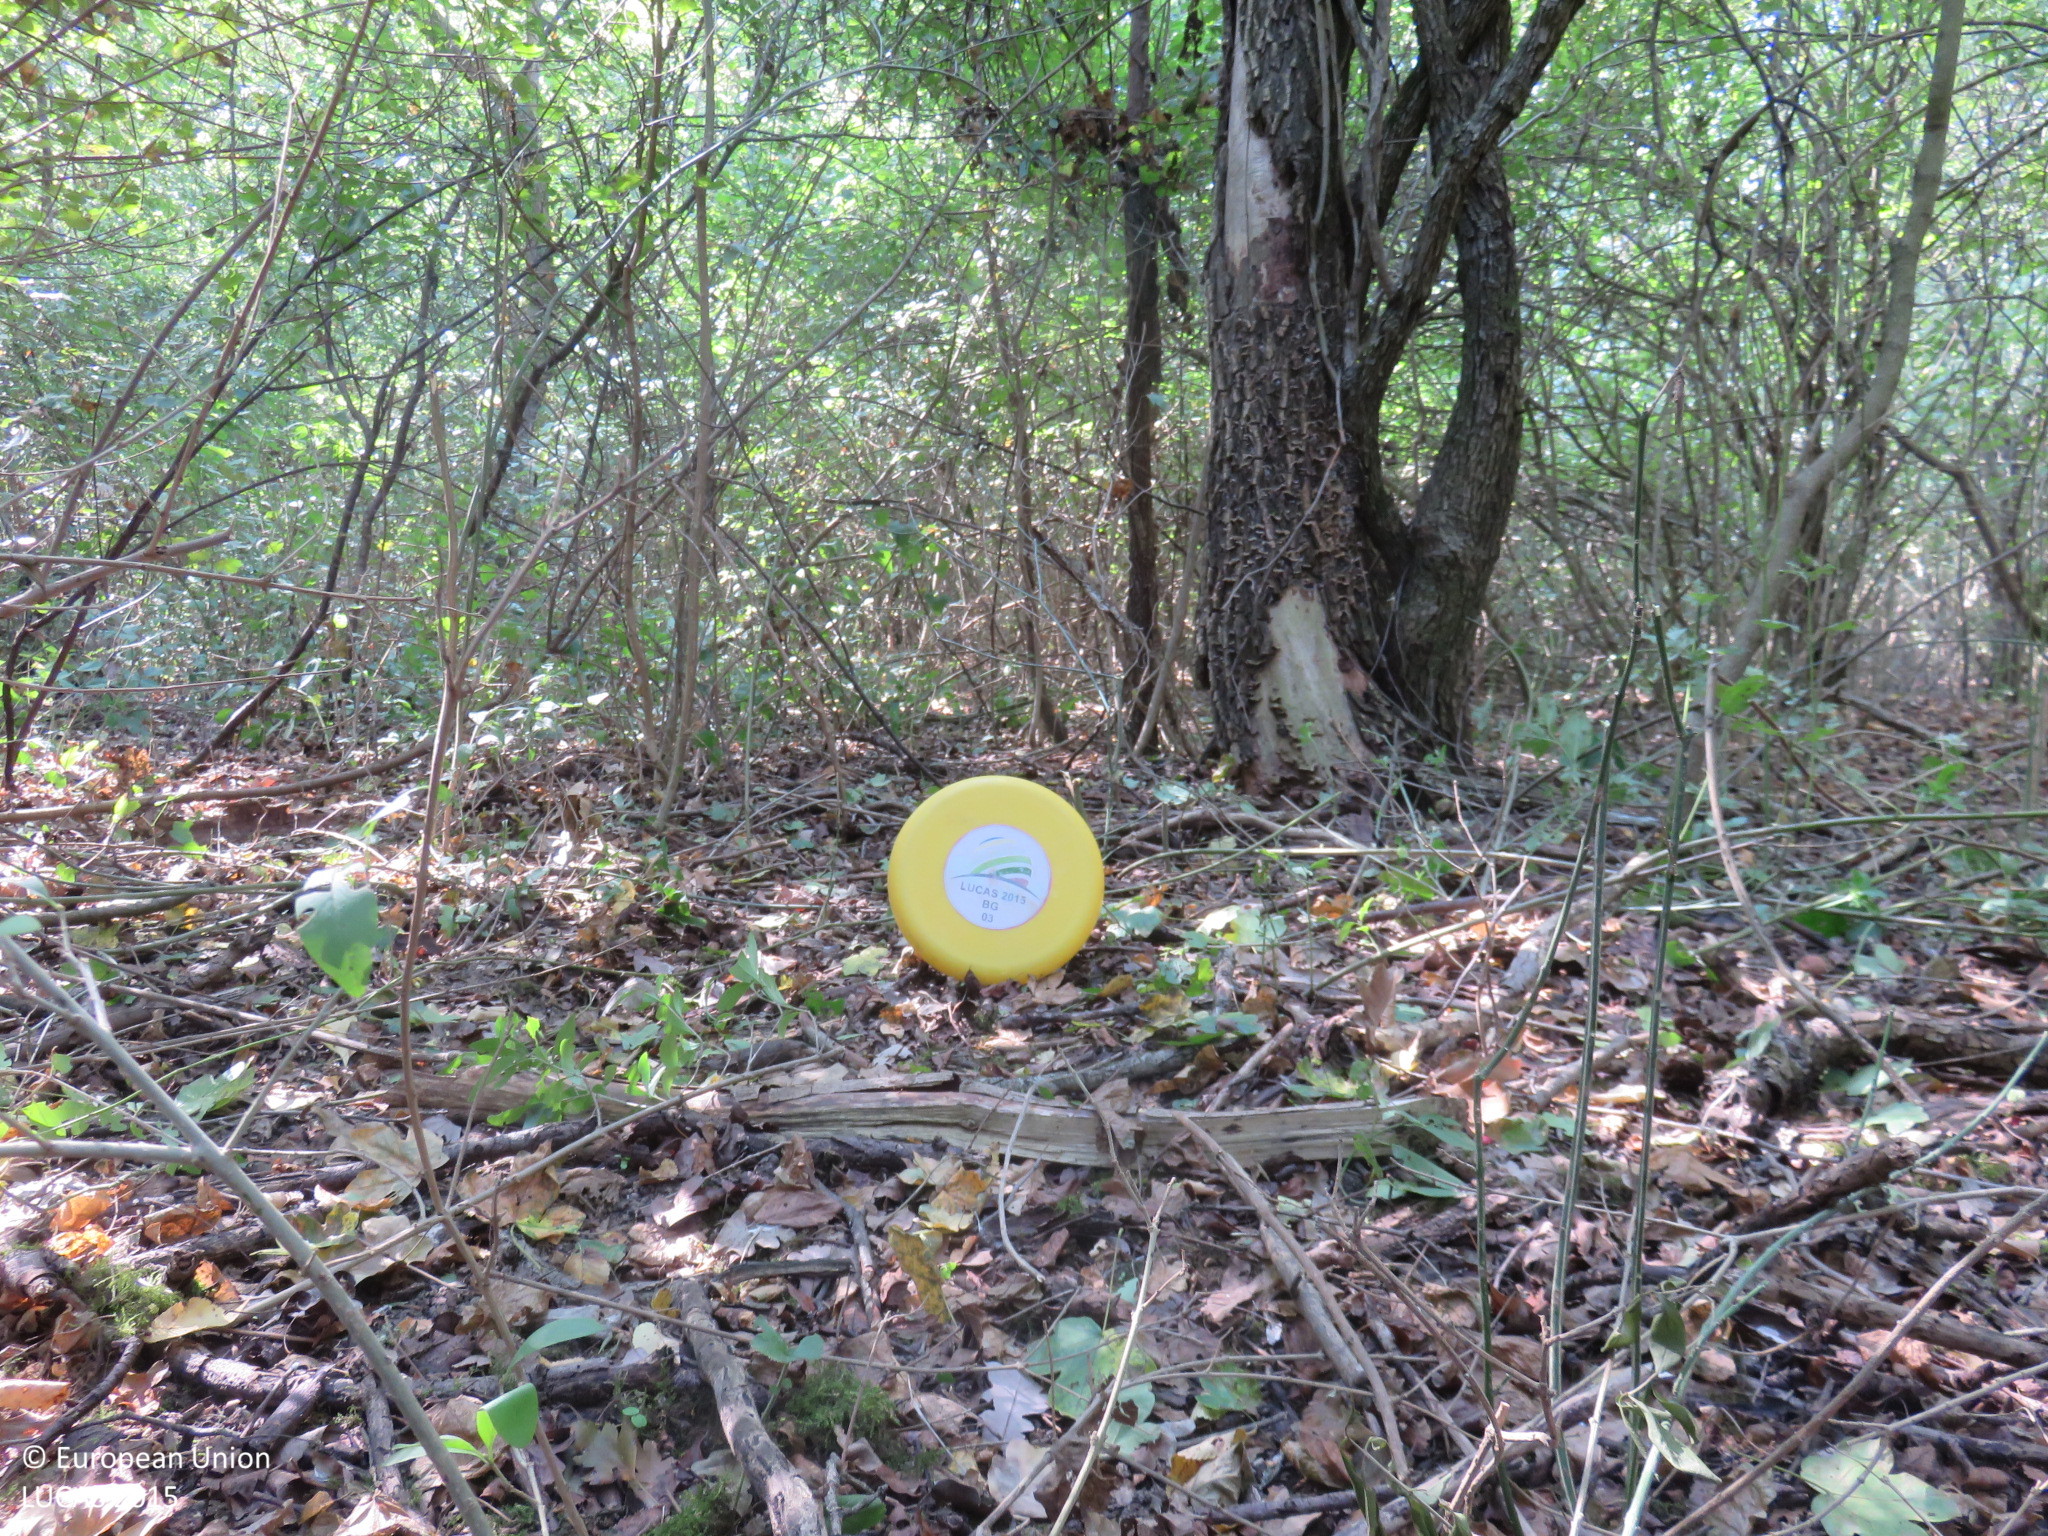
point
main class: Woodland
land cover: Broadleaved woodland
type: mesophytic deciduous forest
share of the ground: > 75 %
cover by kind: broadleaved forest trees 95 %, shrubs 5 %
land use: Forestry
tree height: < 5 m
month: September
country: BG
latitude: 43.4952
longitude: 24.9722
